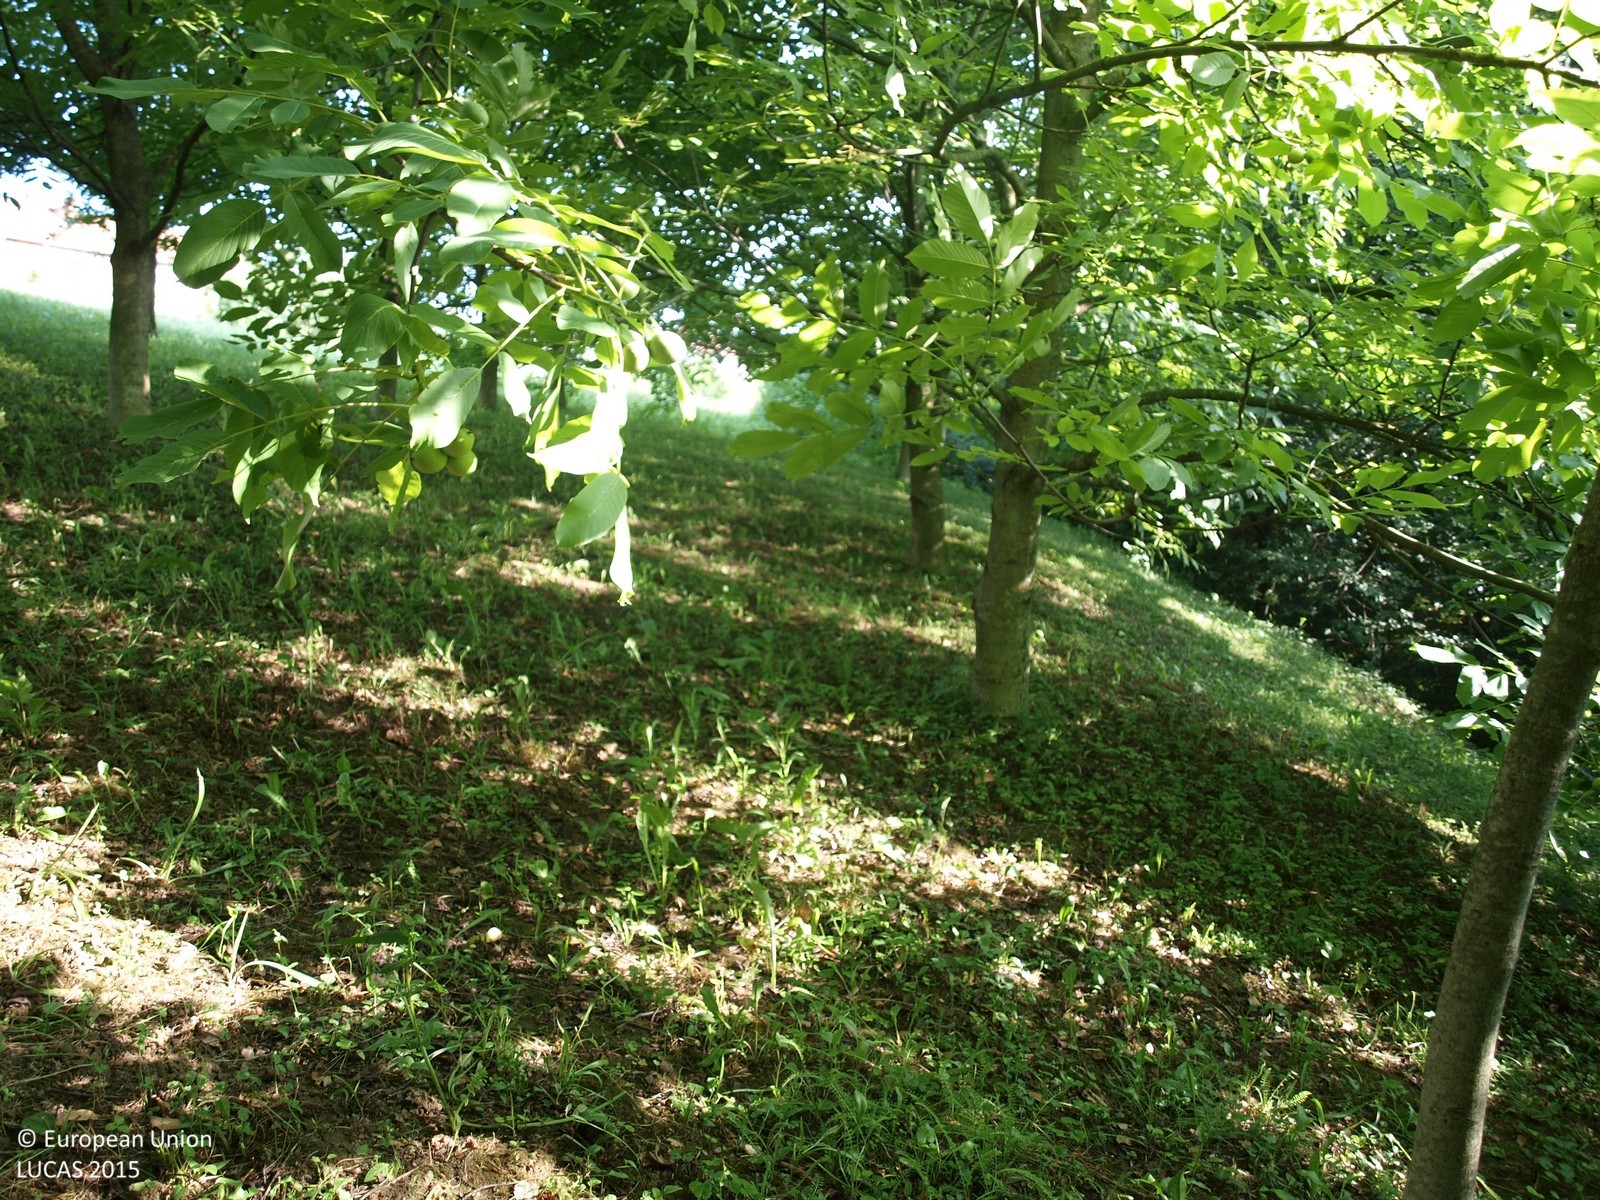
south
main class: Cropland
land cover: Nuts trees
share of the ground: 50 - 75 %
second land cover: Grassland without tree/shrub cover
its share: > 75 %
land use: Agriculture (excluding fallow land and kitchen gardens)
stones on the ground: < 10 %
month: June
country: HR
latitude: 46.1620
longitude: 16.3584
